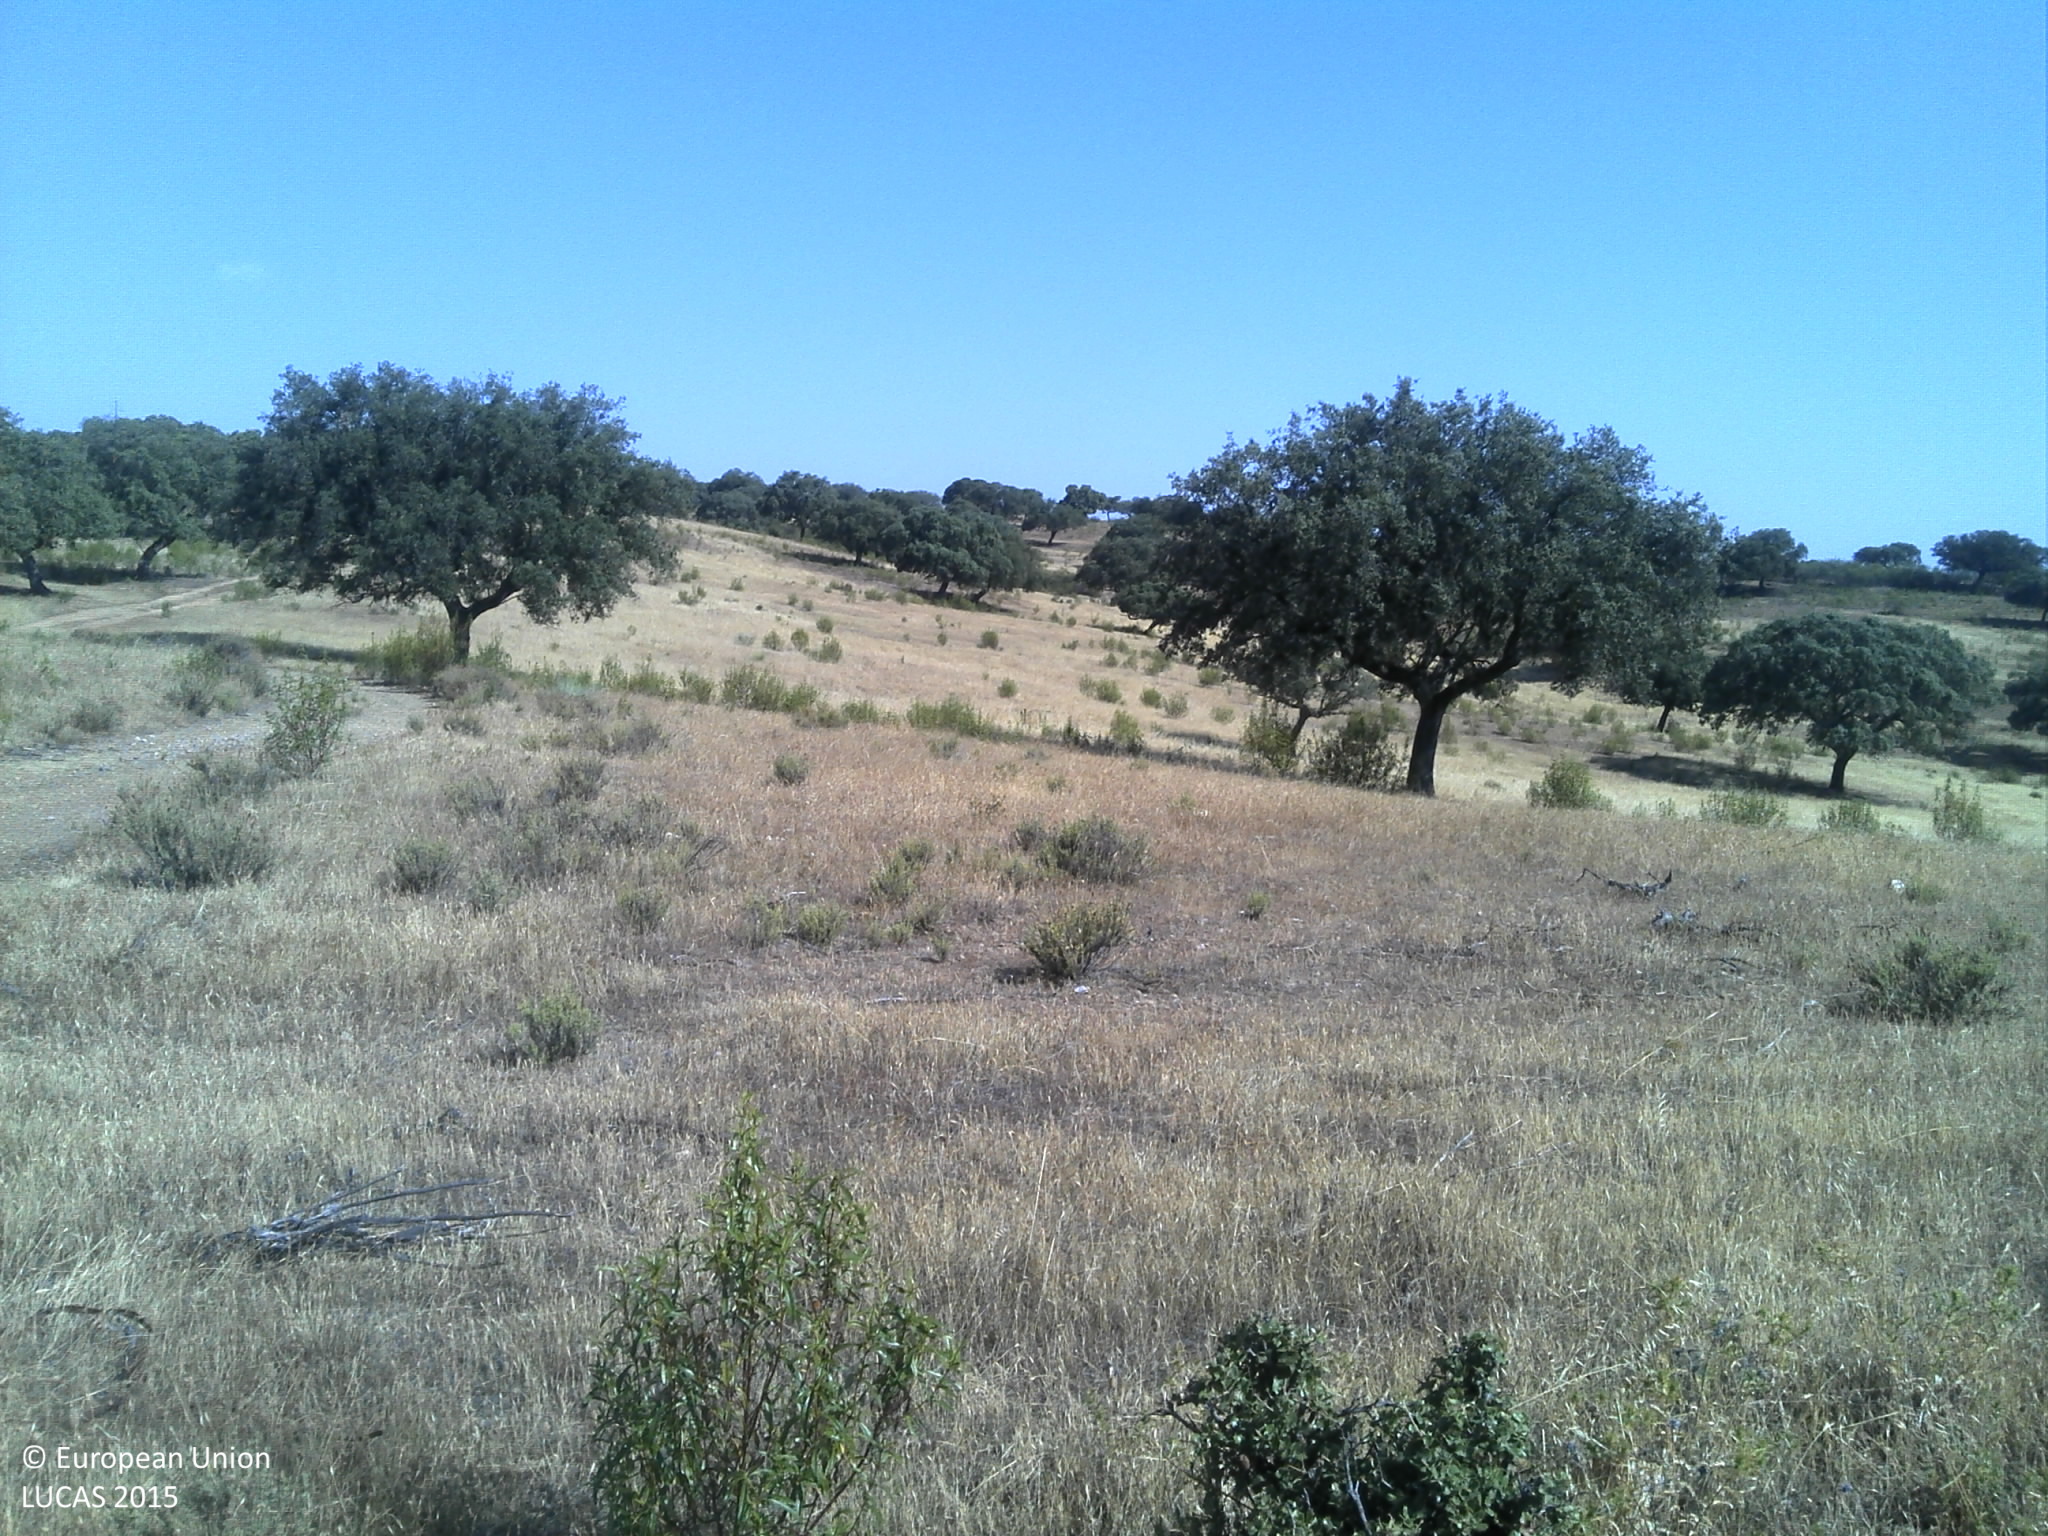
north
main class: Woodland
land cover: Broadleaved woodland
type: broadleaved evergreen forest
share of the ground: 25 - 50 %
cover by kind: shrubs 45 %, broadleaved forest trees 30 %, herbaceous plants 15 %, unconsolidated bare surface 5 %
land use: Forestry
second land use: Other primary production
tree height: > 5 m
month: June
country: PT
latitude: 39.6884
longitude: -7.0284
